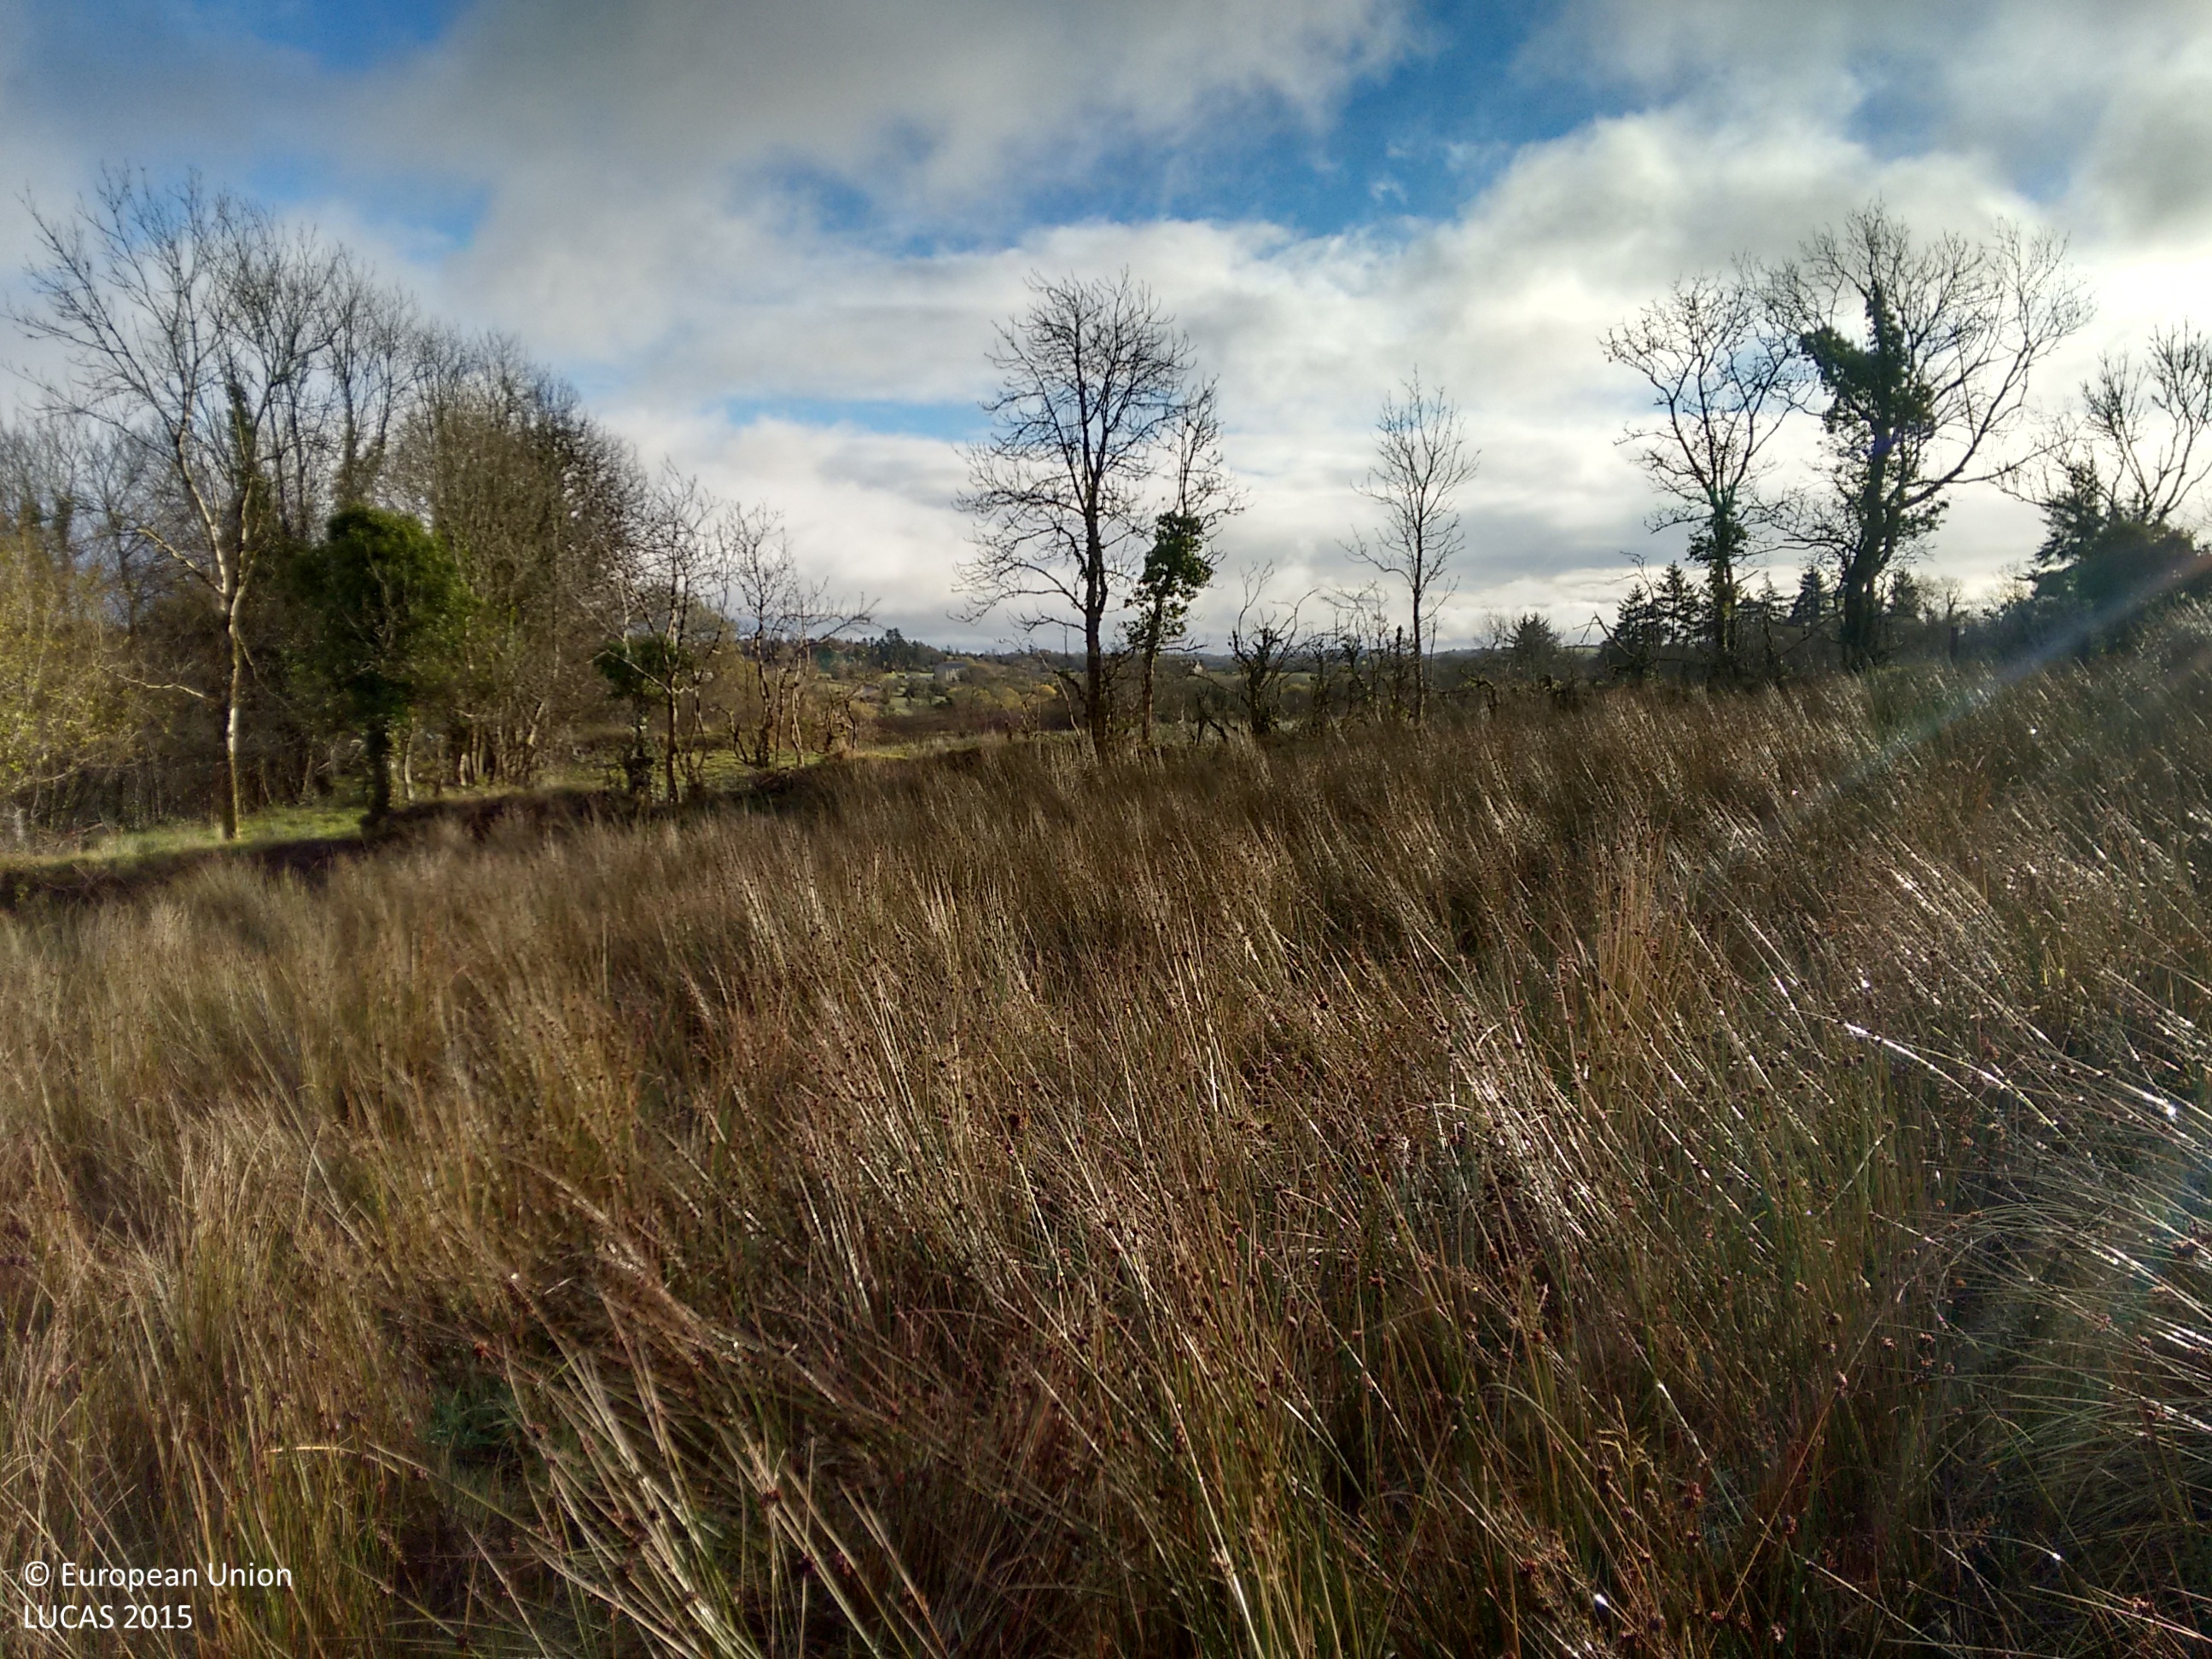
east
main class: Grassland
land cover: Grassland without tree/shrub cover
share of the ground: > 75 %
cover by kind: herbaceous plants 100 %
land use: Agriculture (excluding fallow land and kitchen gardens)
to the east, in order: Grassland without tree/shrub cover; Shruby margins; Ditches and canals; Grassland without tree/shrub cover; Shruby margins; Spontaneously vegetated surfaces; Grassland without tree/shrub cover; Rock outcrops; Broadleaved woodland; Grassland without tree/shrub cover; Fences; Grass margins; Fences; Shruby margins; Ditches and canals; Electric lines; Grass margins; Paved roads, cycling and walking lanes; Artificial constructions; Abandoned hedges; Fences; Grassland without tree/shrub cover; Inland fresh running water; Grassland without tree/shrub cover
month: November
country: IE
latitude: 54.0663
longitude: -7.8793
